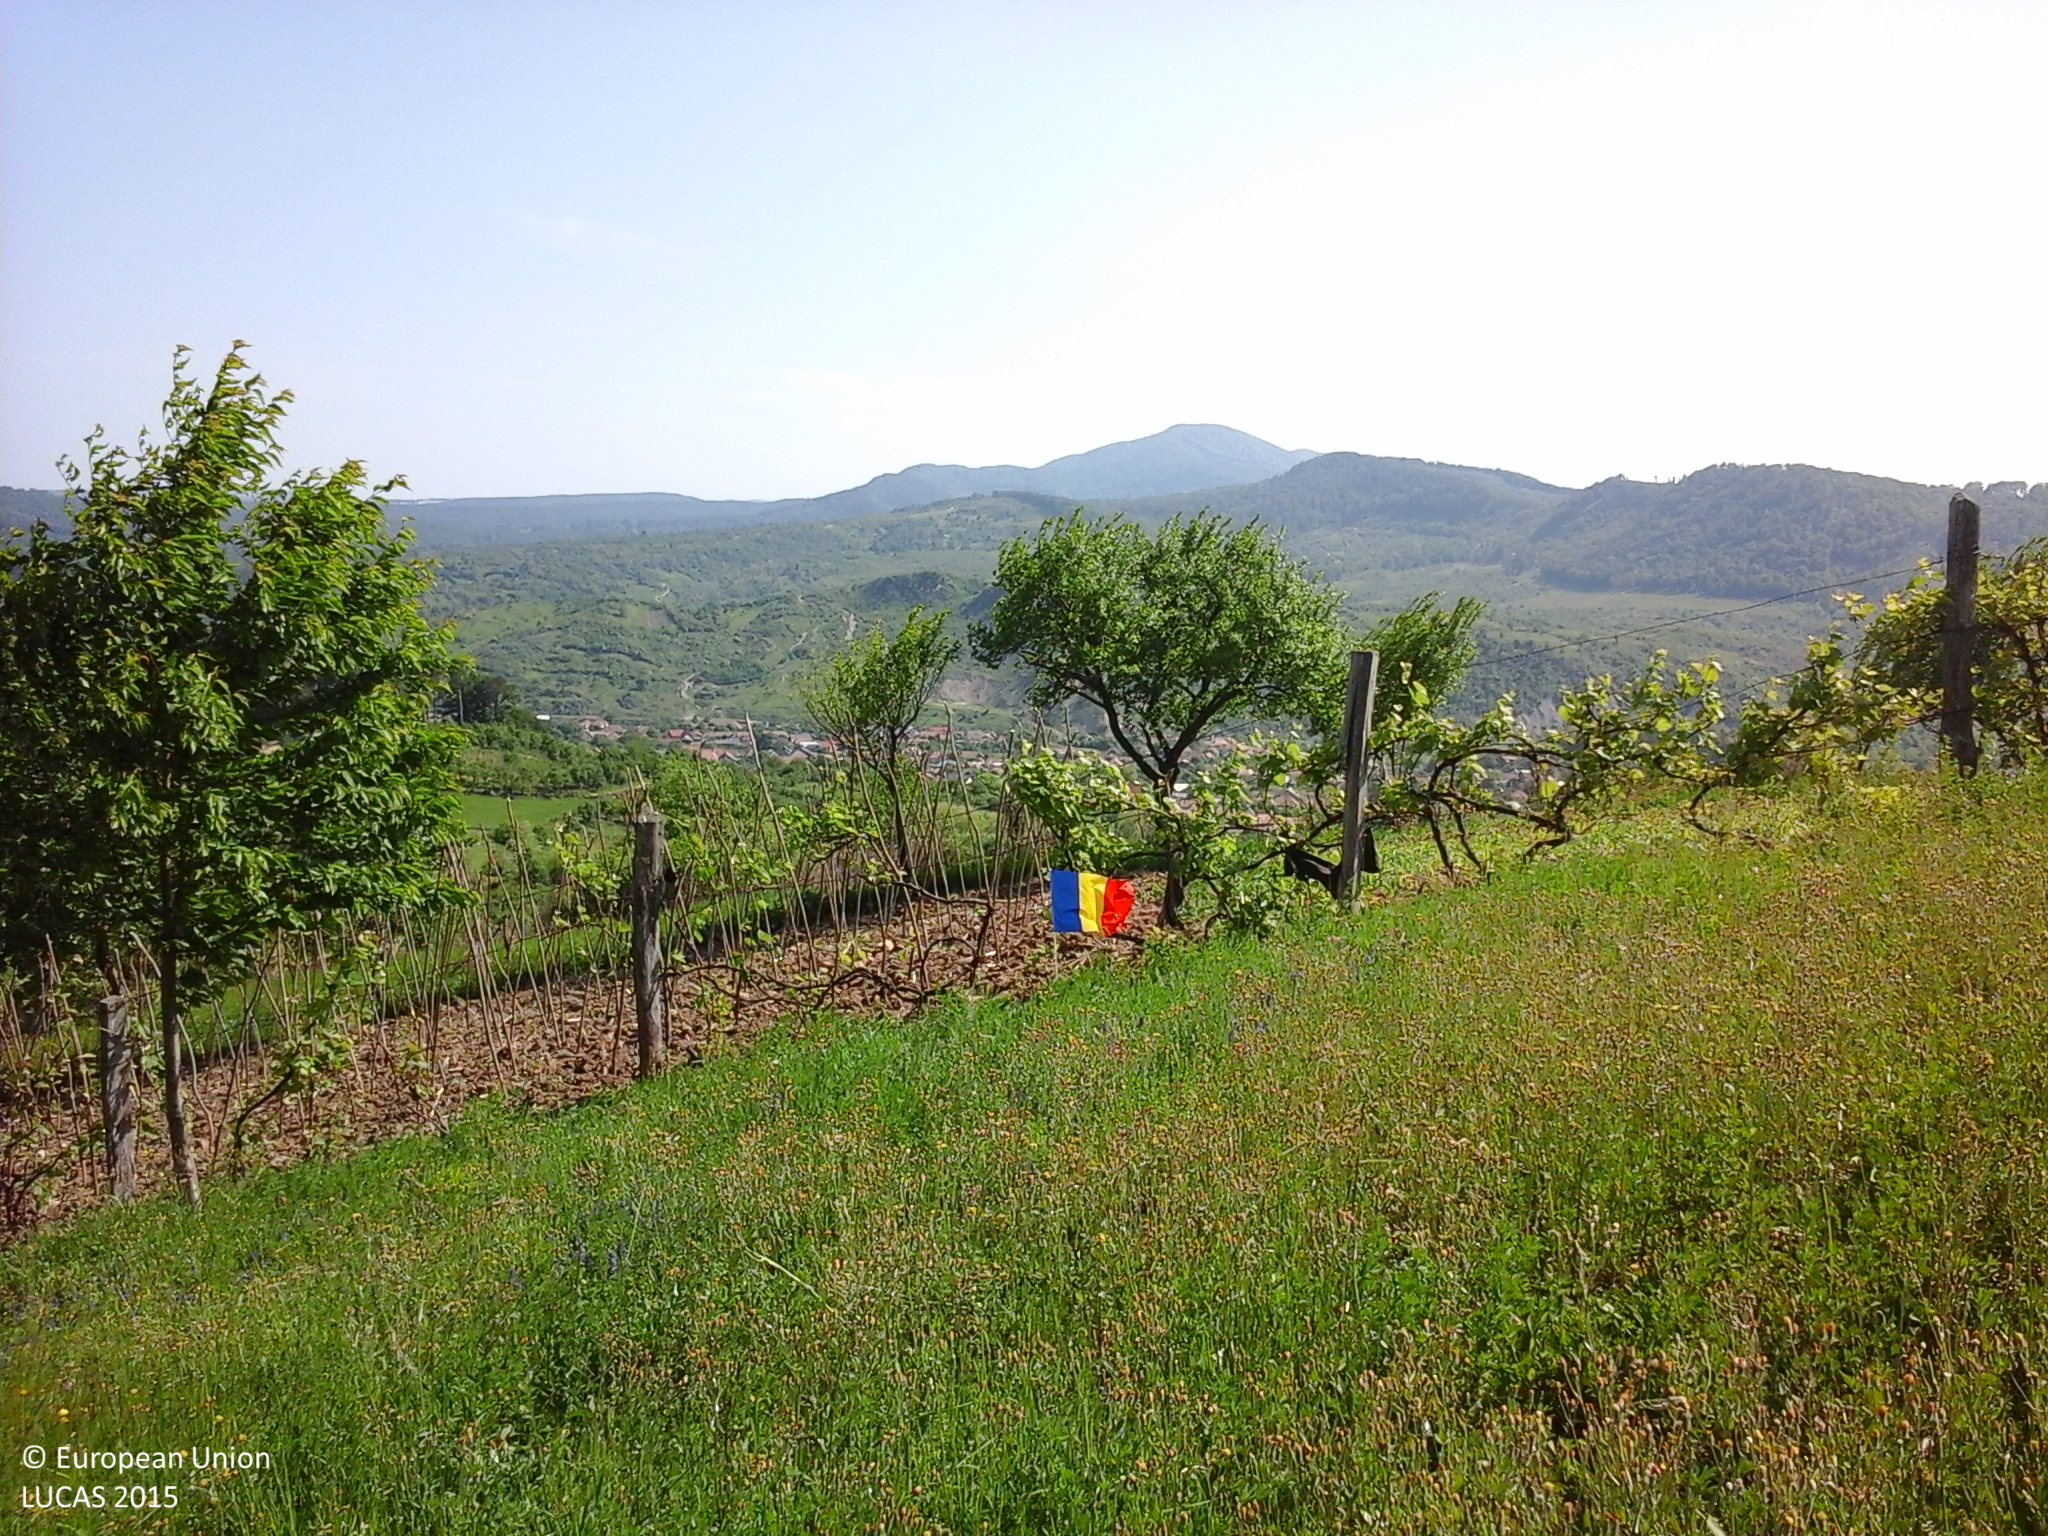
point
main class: Cropland
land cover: Other leguminous and mixtures for fodder
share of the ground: > 75 %
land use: Agriculture (excluding fallow land and kitchen gardens)
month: May
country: RO
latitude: 46.2167
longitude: 26.6109
